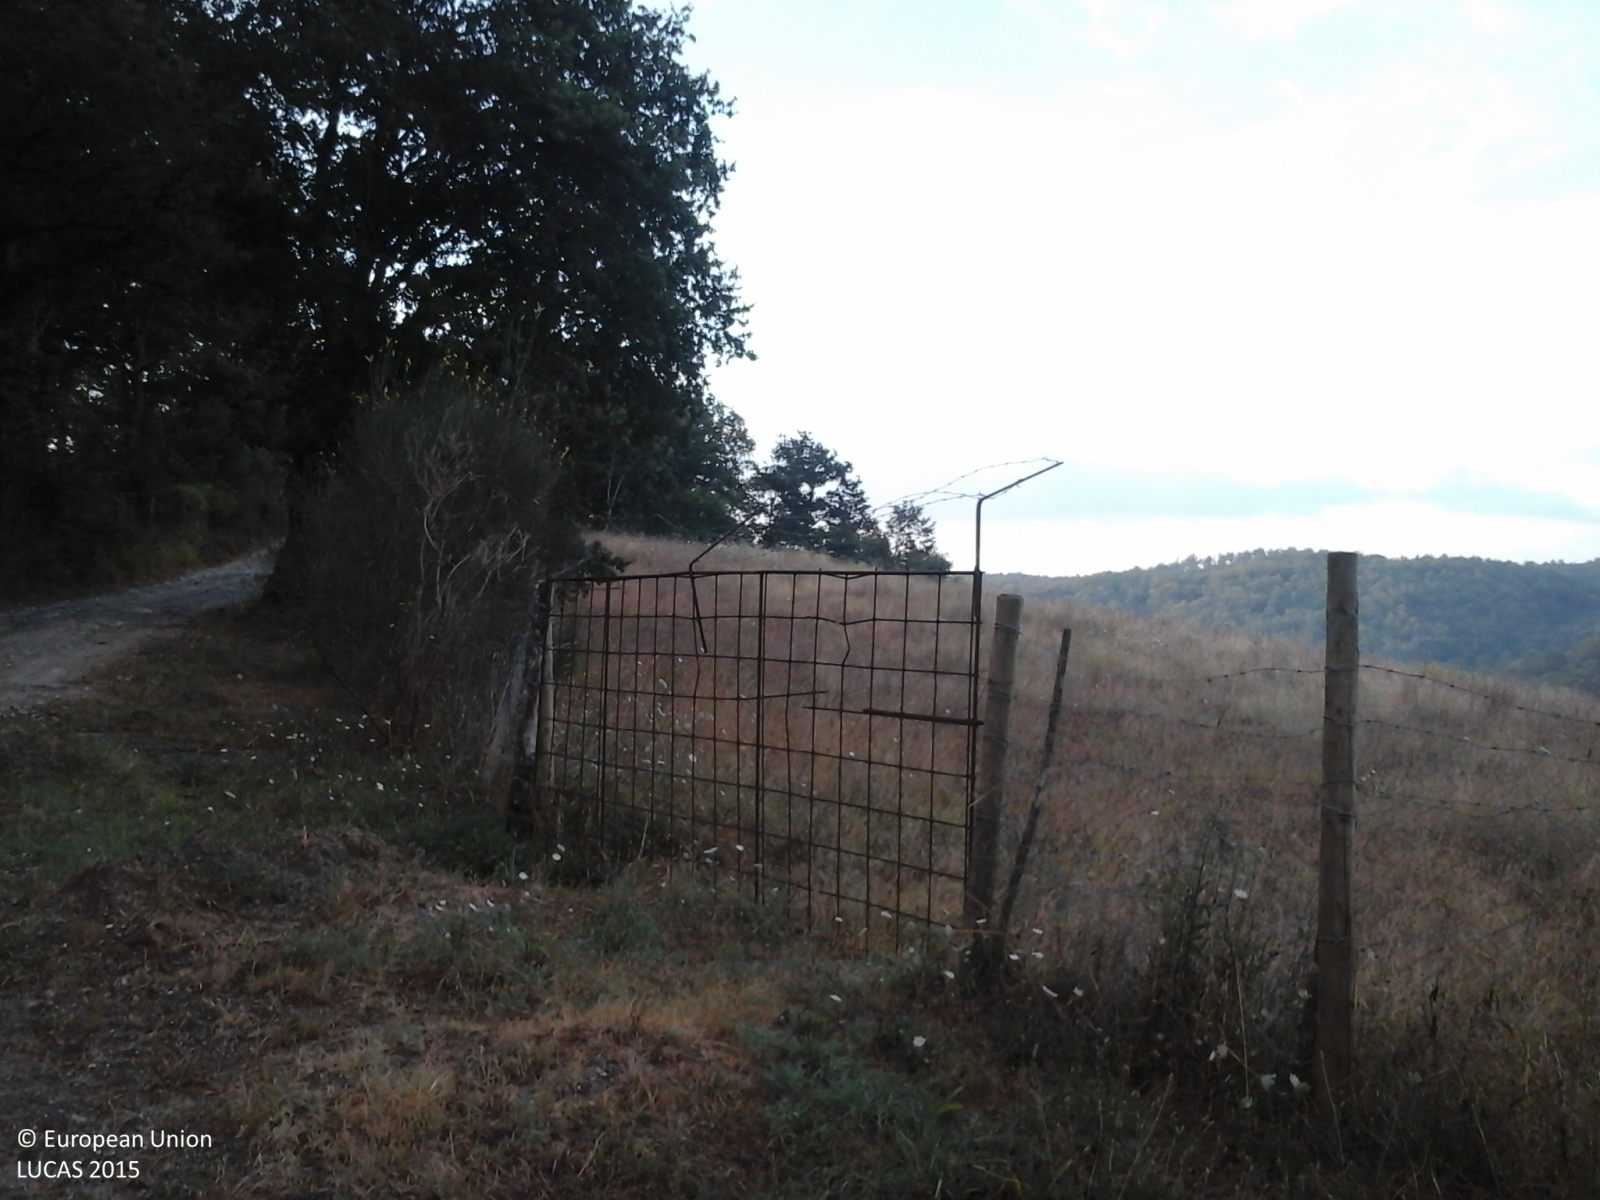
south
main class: Woodland
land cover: Broadleaved woodland
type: thermophilous deciduous forest
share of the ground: > 75 %
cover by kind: broadleaved forest trees 100 %
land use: Forestry
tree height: > 5 m
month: July
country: IT
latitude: 43.4438
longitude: 10.9734
